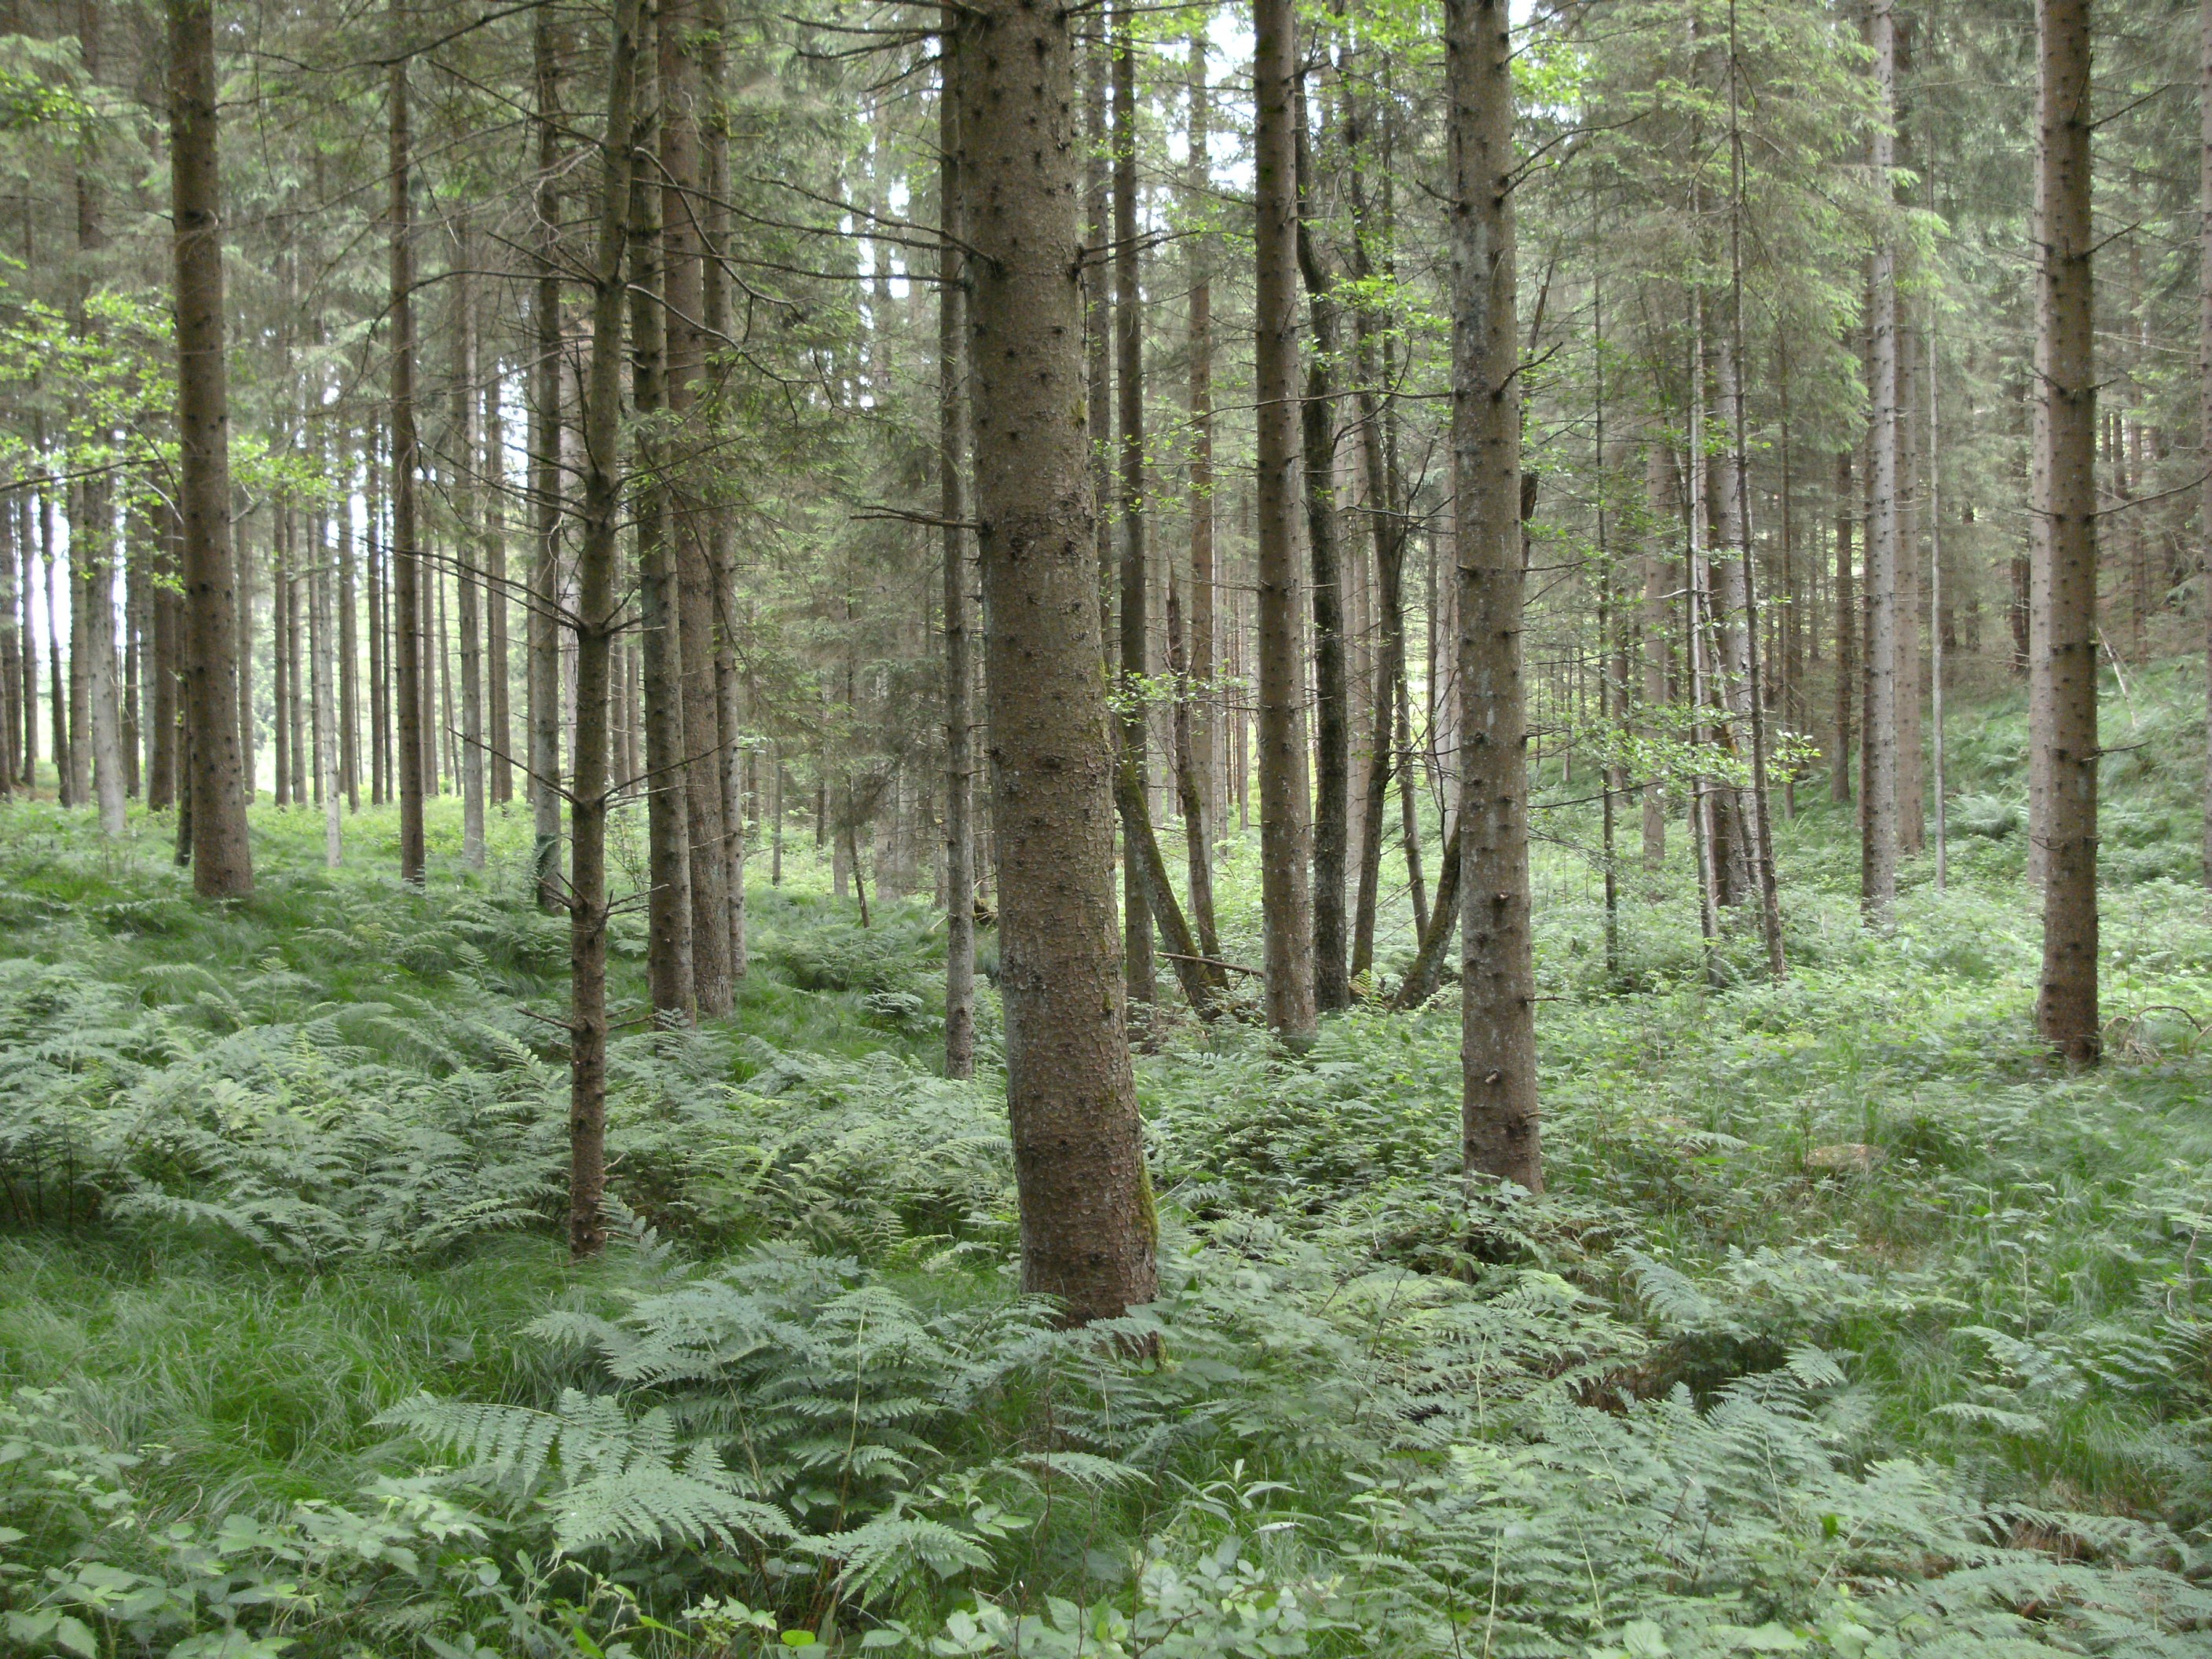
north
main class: Woodland
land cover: Spruce dominated coniferous woodland
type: hemiboreal forest and nemoral coniferous forest and mixed broadleaved-coniferous forest
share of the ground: 50 - 75 %
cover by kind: coniferous forest trees 75 %, shrubs 10 %, herbaceous plants 10 %, broadleaved forest trees 5 %
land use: Forestry
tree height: > 5 m
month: June
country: AT
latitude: 48.5066
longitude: 14.1285
